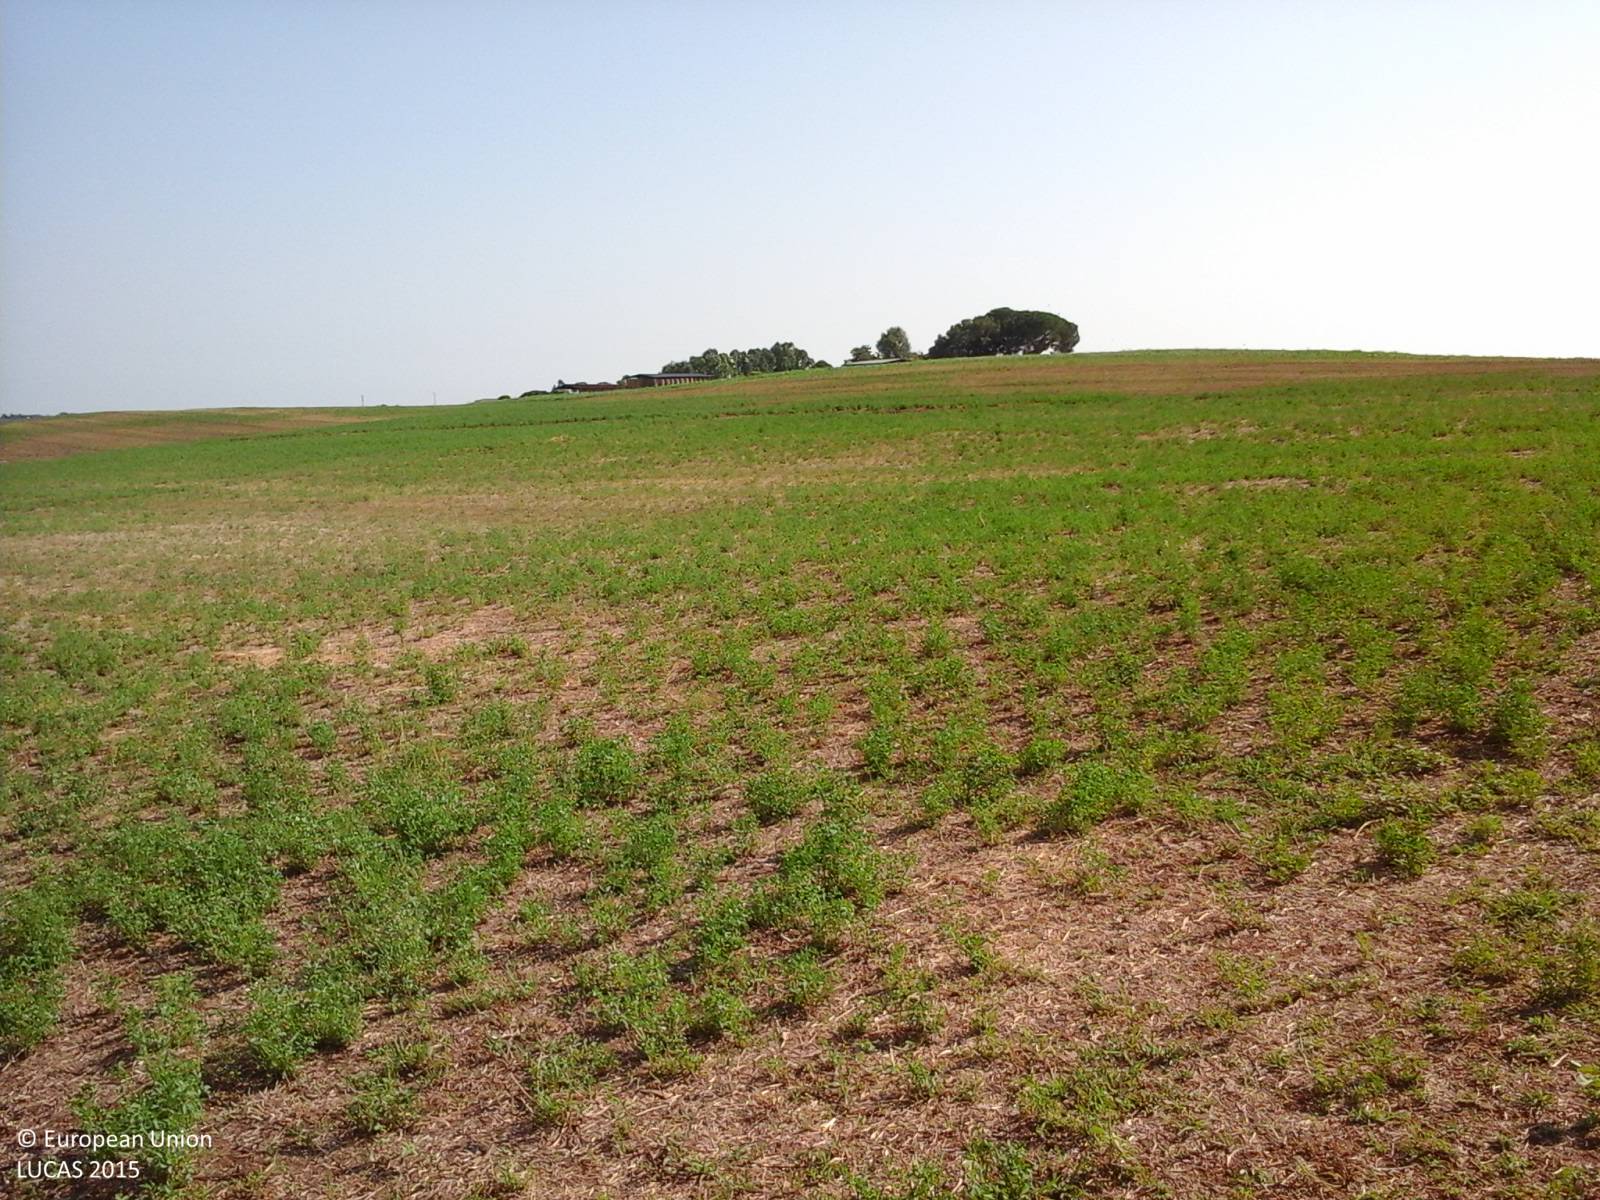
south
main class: Cropland
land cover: Maize
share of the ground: > 75 %
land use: Agriculture (excluding fallow land and kitchen gardens)
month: July
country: IT
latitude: 42.0305
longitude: 12.3467
